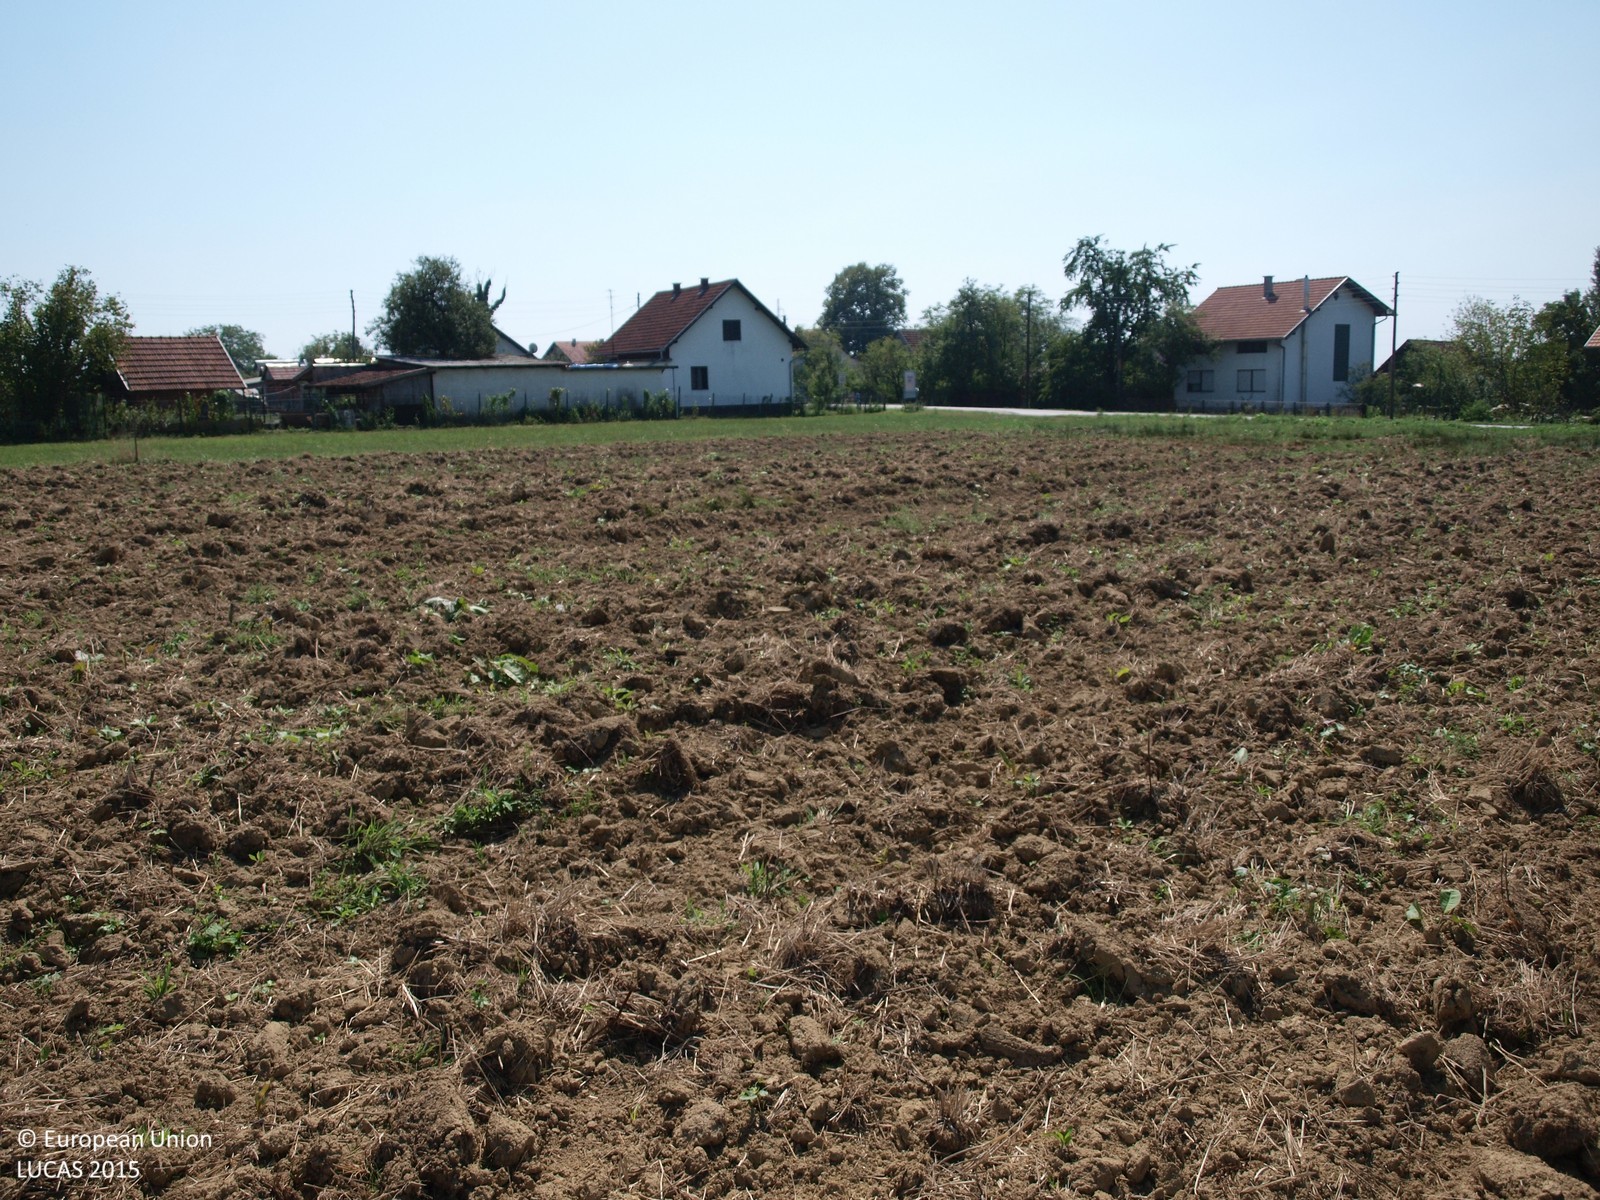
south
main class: Cropland
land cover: Common wheat
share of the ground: > 75 %
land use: Agriculture (excluding fallow land and kitchen gardens)
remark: Harvested field
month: August
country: HR
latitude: 45.7026
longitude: 16.4849
